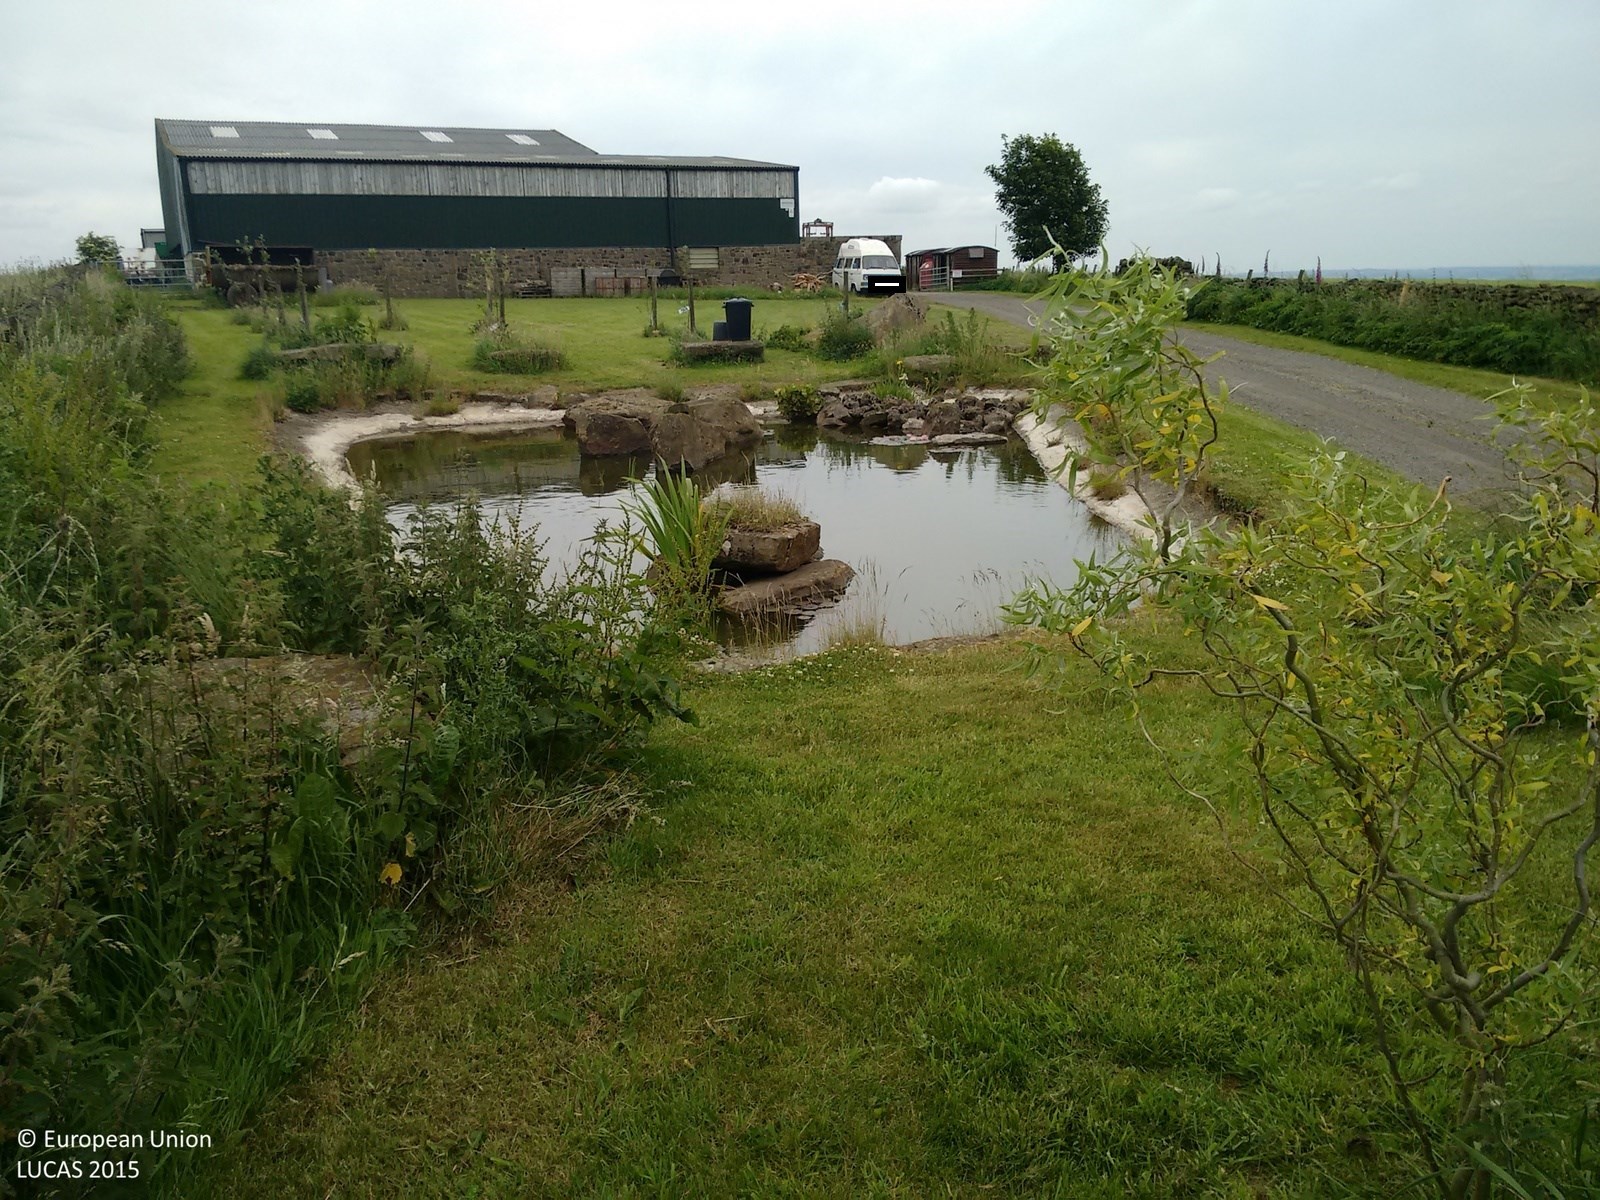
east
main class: Cropland
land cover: Barley
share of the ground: > 75 %
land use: Agriculture (excluding fallow land and kitchen gardens)
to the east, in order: Barley; Fences; Dry stone walls; Arable land (only in case pi); Dry stone walls; Other mixed woodland
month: July
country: GB
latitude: 53.1439
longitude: -1.4873
